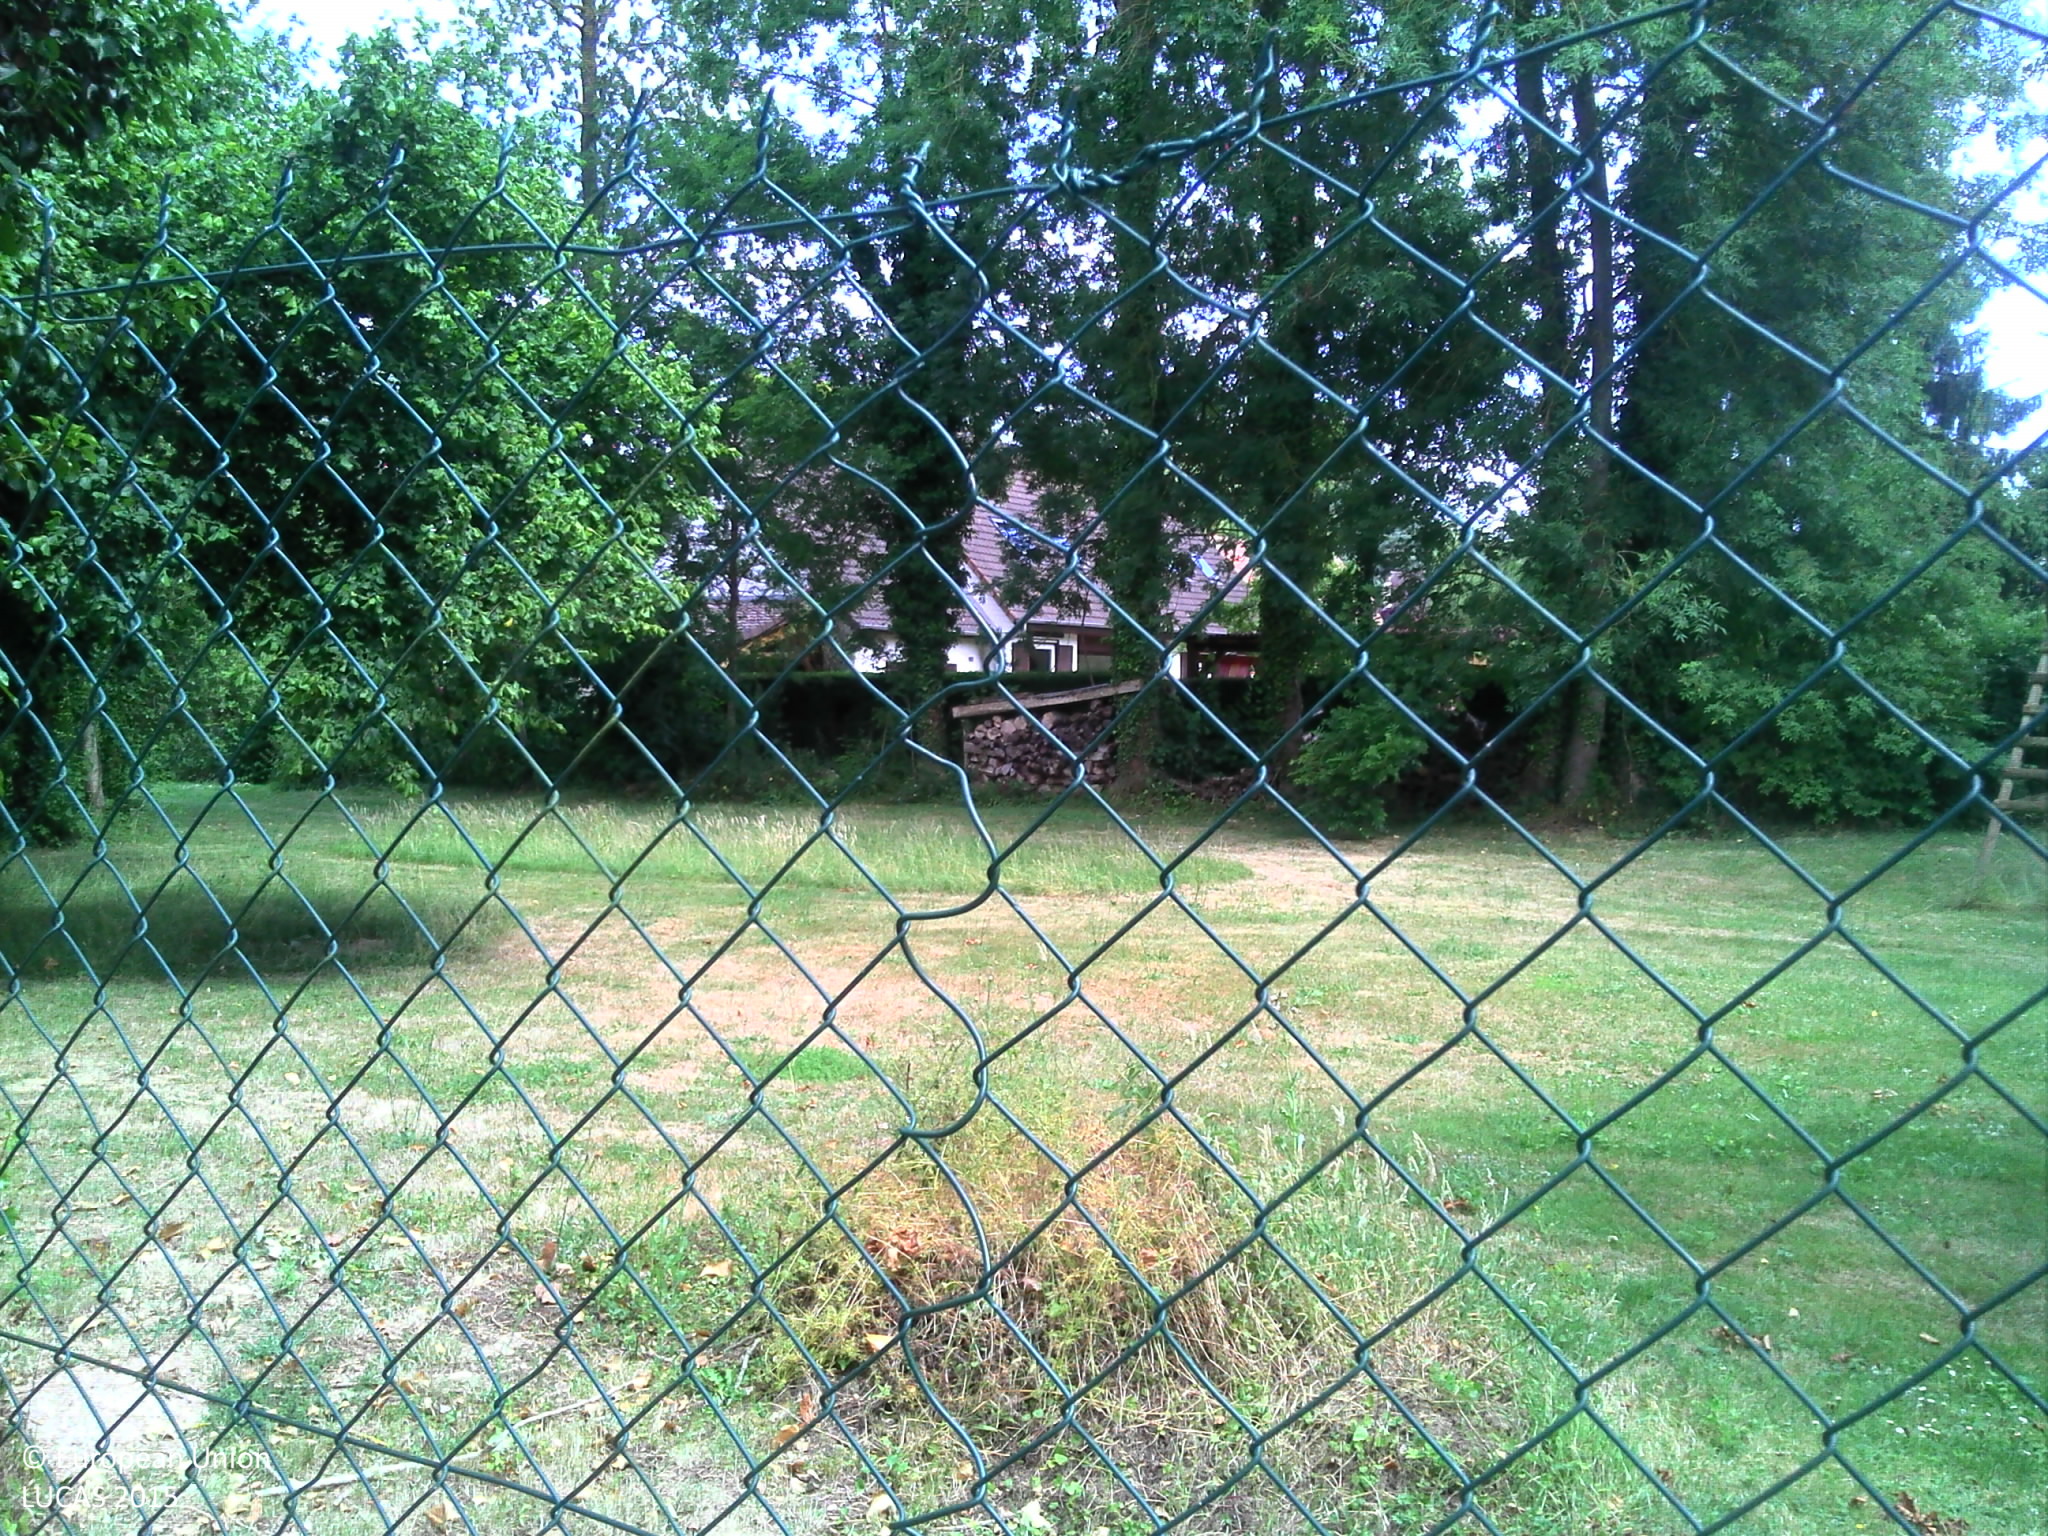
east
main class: Grassland
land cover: Grassland without tree/shrub cover
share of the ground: > 75 %
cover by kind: herbaceous plants 100 %
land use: Residential
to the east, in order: Grassland without tree/shrub cover; Artificial constructions in urban areas
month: June
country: FR
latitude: 49.0724
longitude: 1.2882
